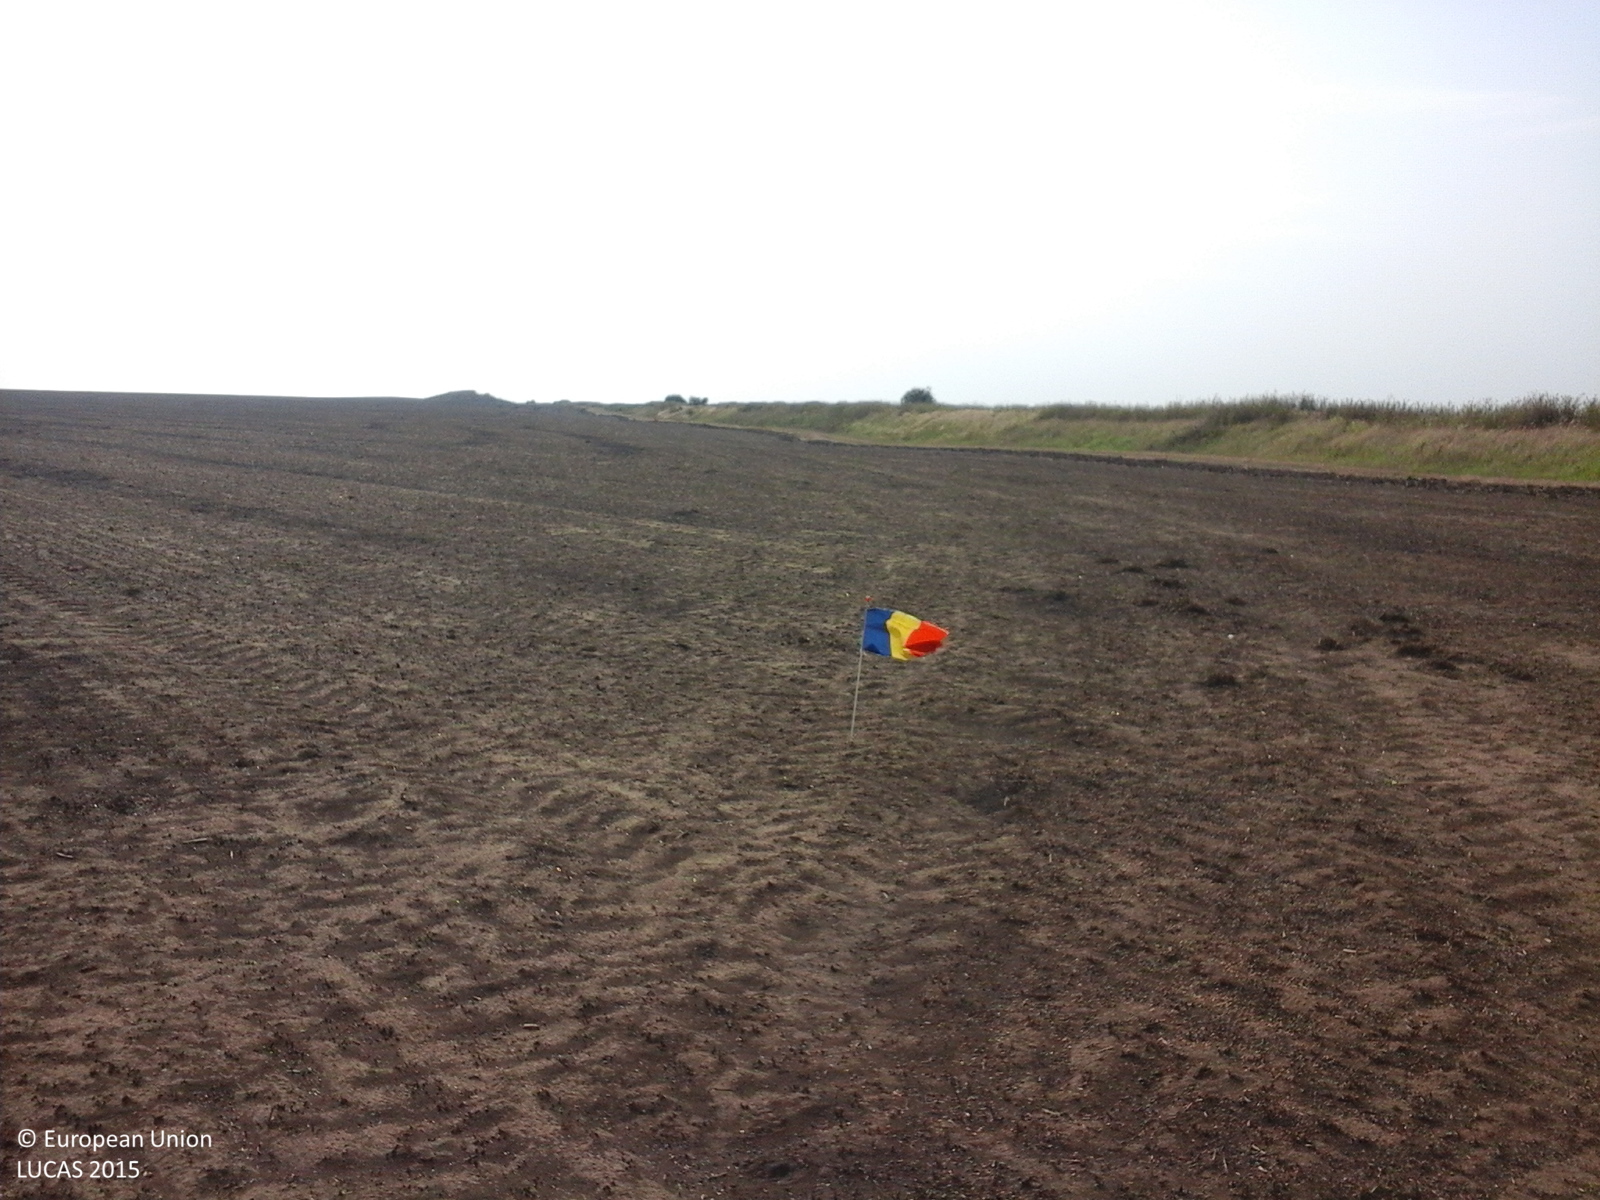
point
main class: Cropland
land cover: Common wheat
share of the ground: < 10 %
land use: Agriculture (excluding fallow land and kitchen gardens)
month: August
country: RO
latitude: 43.8488
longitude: 28.4112
